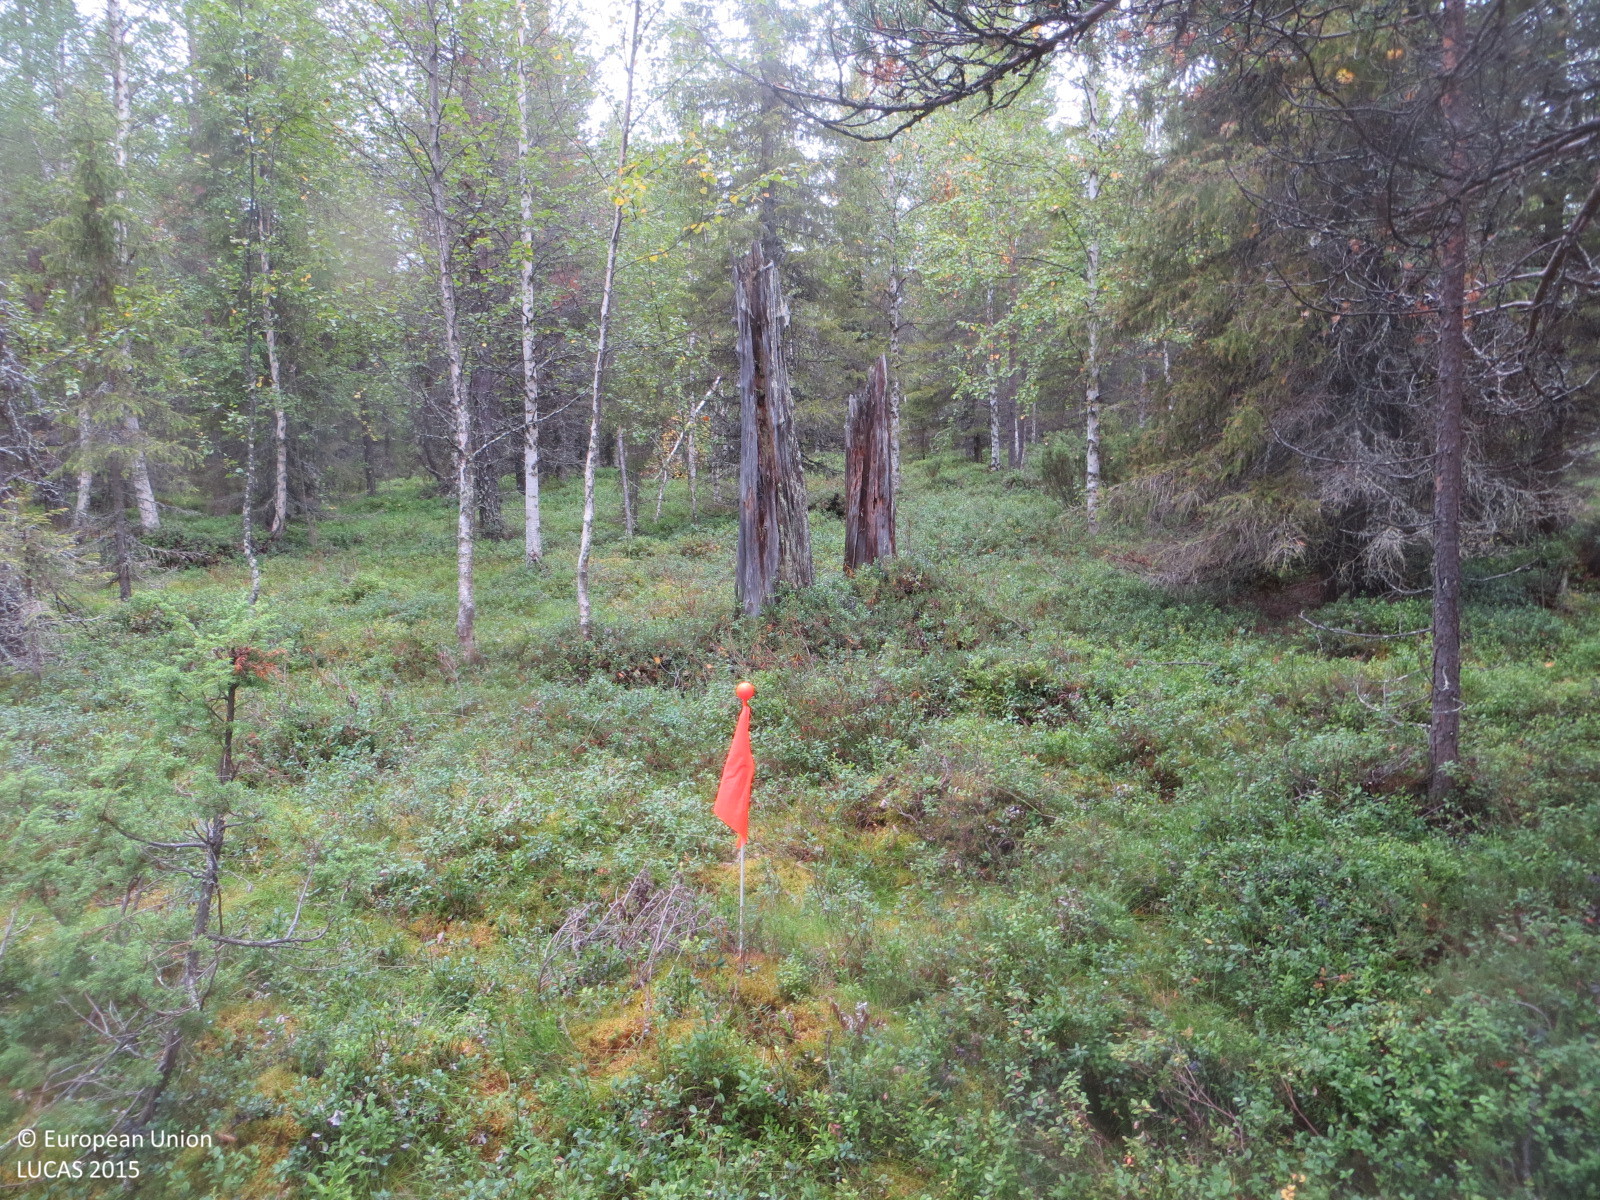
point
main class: Woodland
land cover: Other mixed woodland
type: boreal forest
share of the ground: 50 - 75 %
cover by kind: shrubs 50 %, coniferous forest trees 25 %, broadleaved forest trees 25 %
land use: Forestry
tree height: > 5 m
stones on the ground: < 10 %
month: August
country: FI
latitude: 67.5534
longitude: 24.4629
